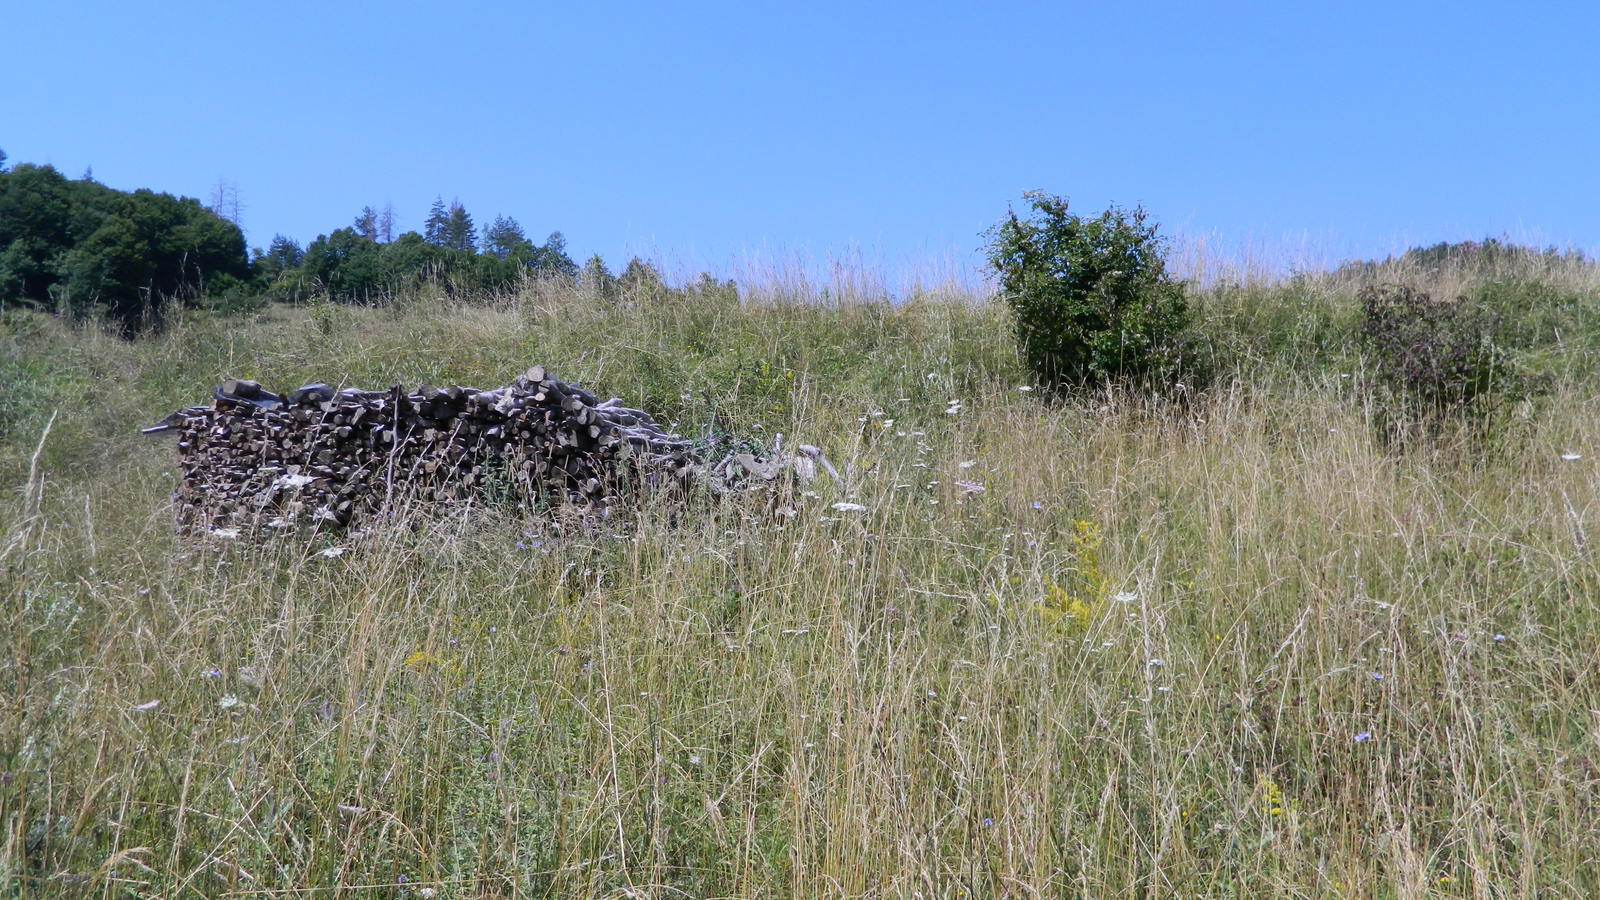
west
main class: Grassland
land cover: Grassland without tree/shrub cover
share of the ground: > 75 %
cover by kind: herbaceous plants 100 %
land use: Agriculture (excluding fallow land and kitchen gardens)
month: July
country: BG
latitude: 41.5272
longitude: 24.7733
